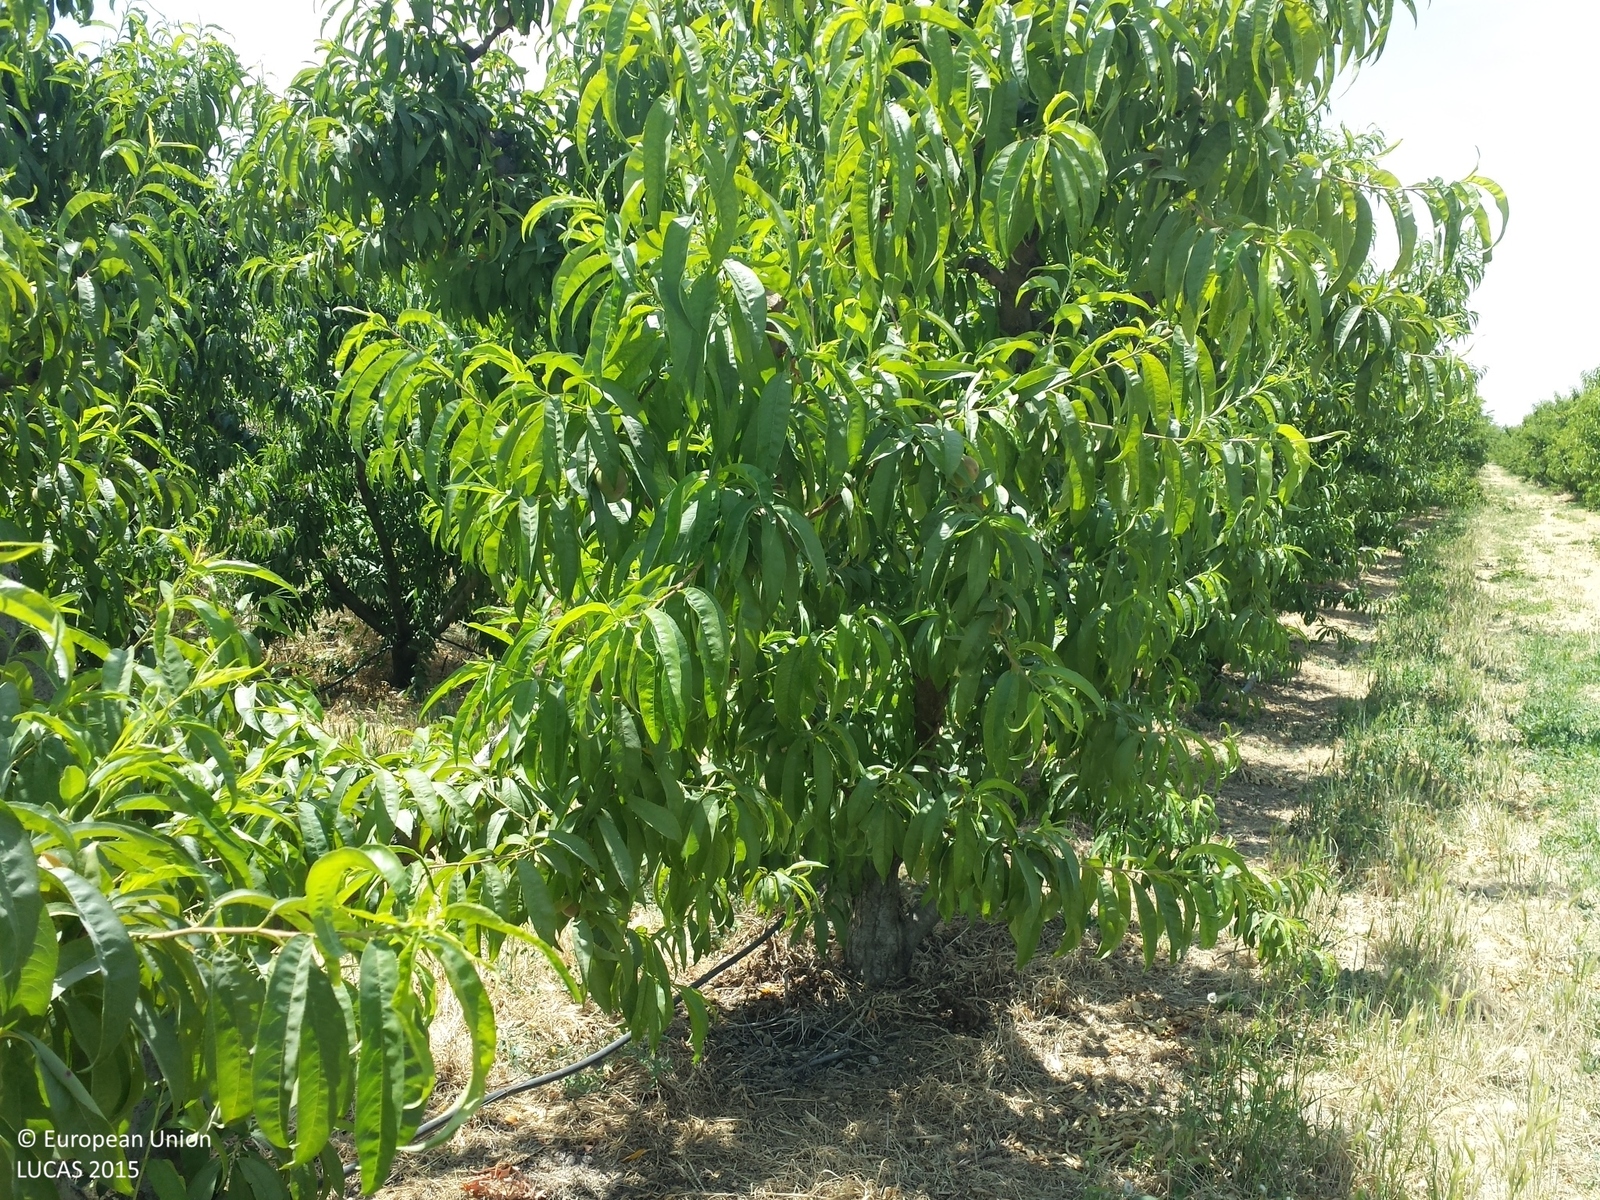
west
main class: Cropland
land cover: Other fruit trees and berries
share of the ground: 25 - 50 %
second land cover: Spontaneously vegetated surfaces
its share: 50 - 75 %
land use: Agriculture (excluding fallow land and kitchen gardens)
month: June
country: ES
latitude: 41.5705
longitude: 0.6942
